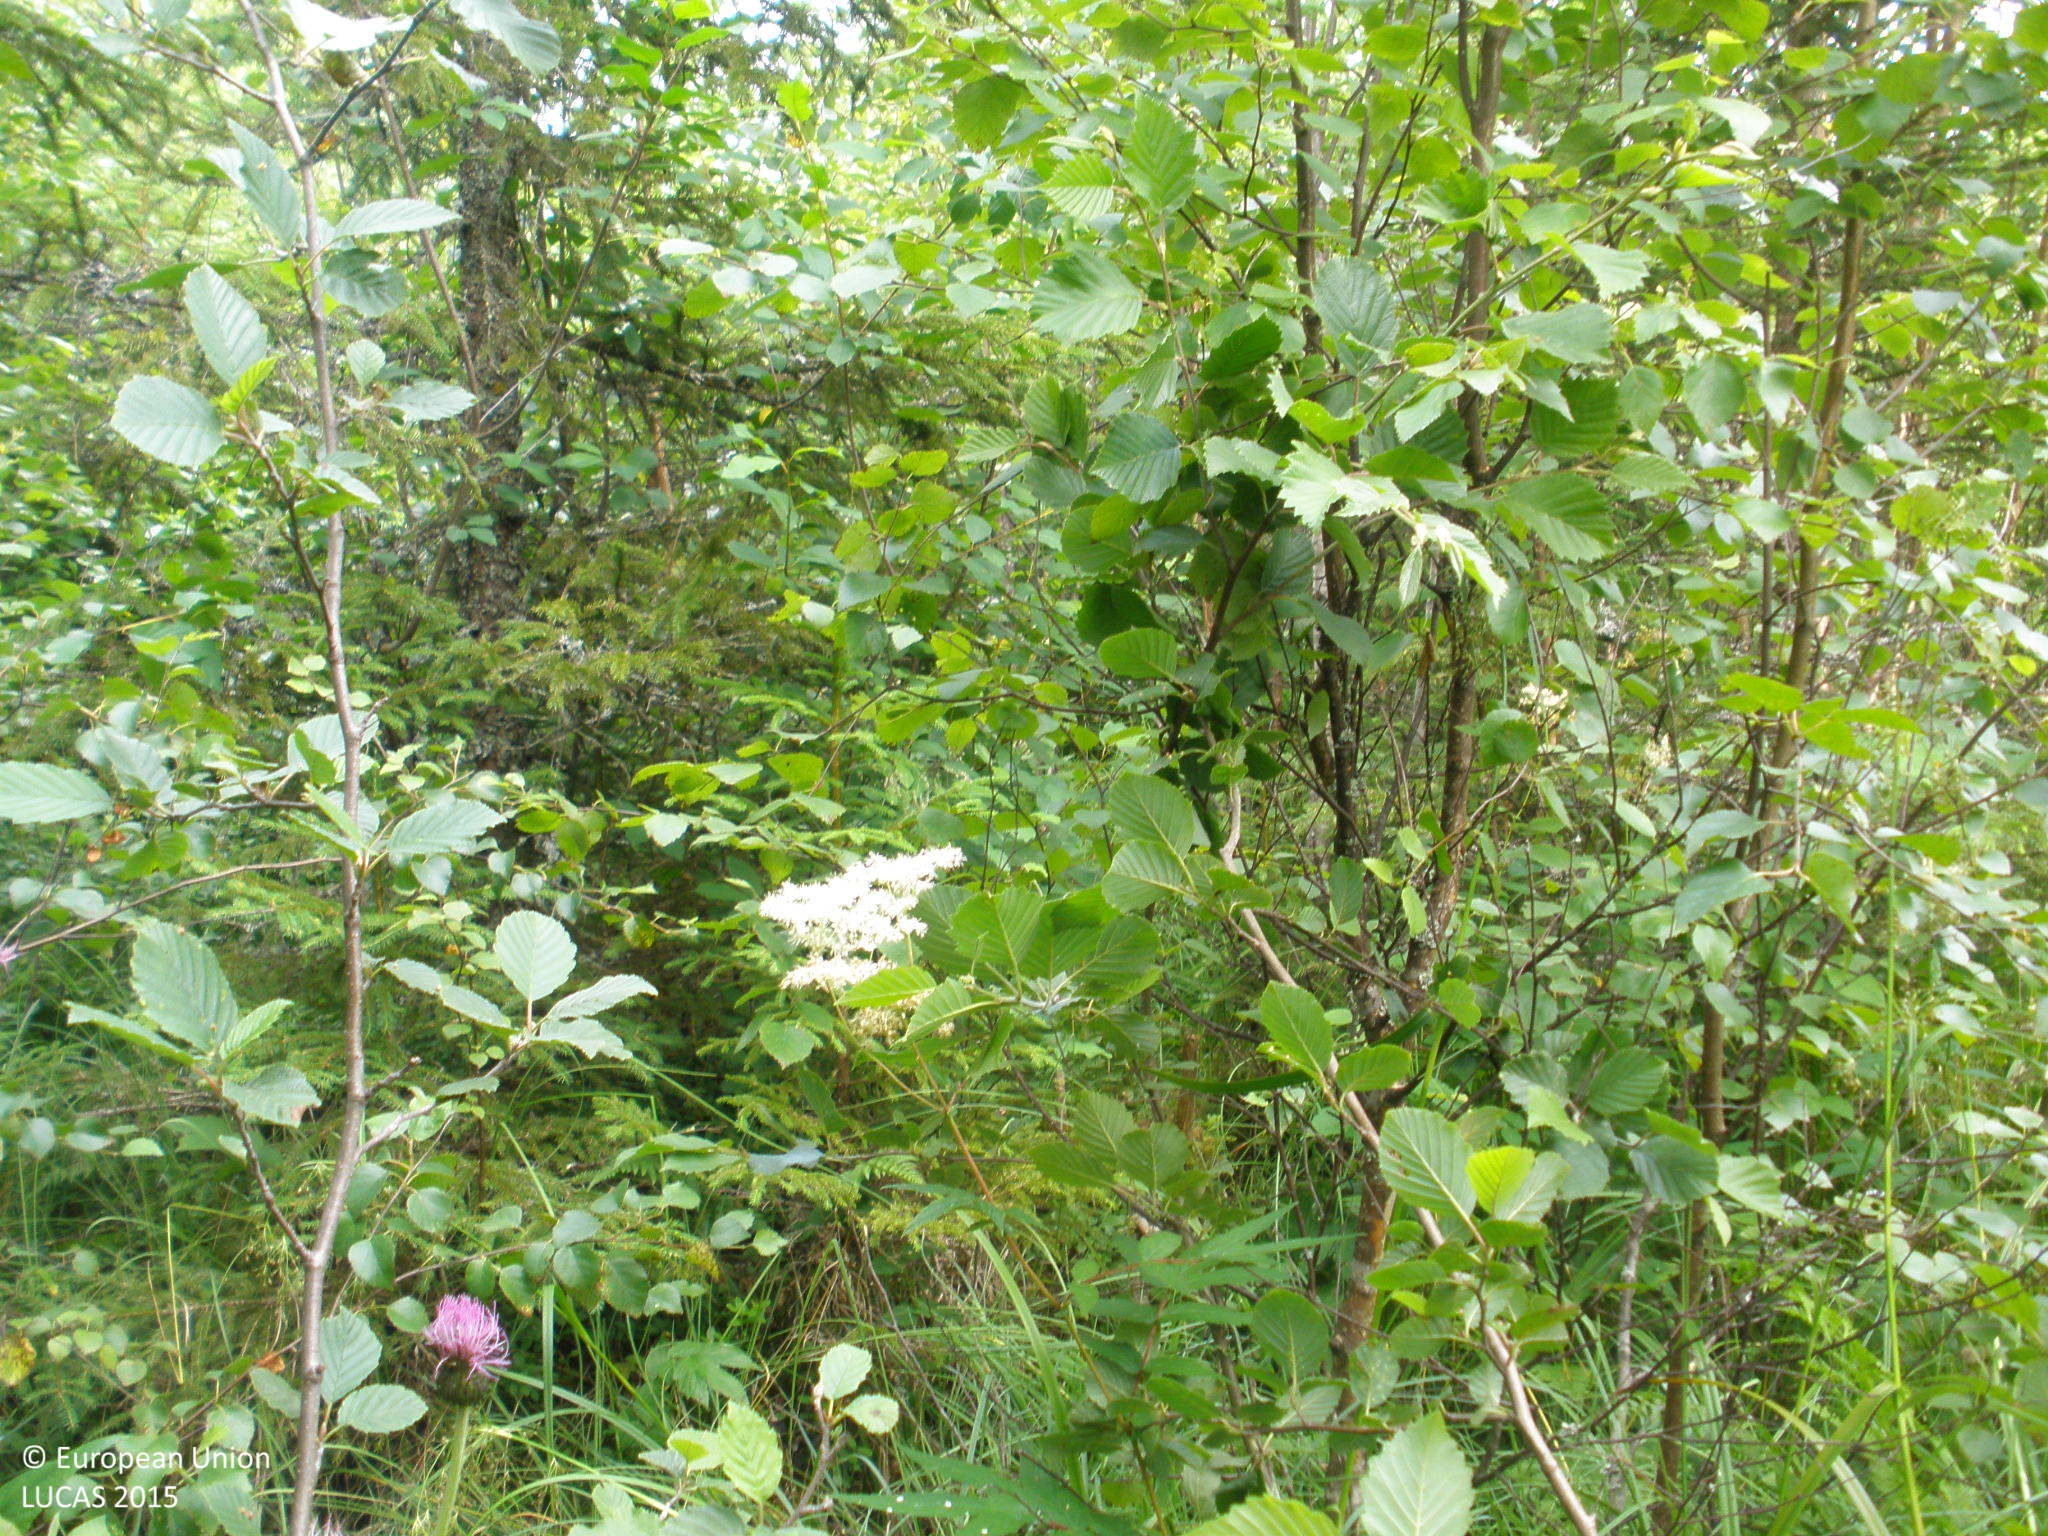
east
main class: Woodland
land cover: Broadleaved woodland
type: boreal forest
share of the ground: > 75 %
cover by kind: broadleaved forest trees 75 %, coniferous forest trees 10 %, herbaceous plants 10 %, shrubs 5 %
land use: Forestry
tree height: < 5 m
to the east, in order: Broadleaved woodland; Spruce dominated mixed woodland; Ditches and canals; Spruce dominated mixed woodland; Other mixed woodland; Spruce dominated mixed woodland; Broadleaved woodland
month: July
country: FI
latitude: 60.9800
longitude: 24.1961
